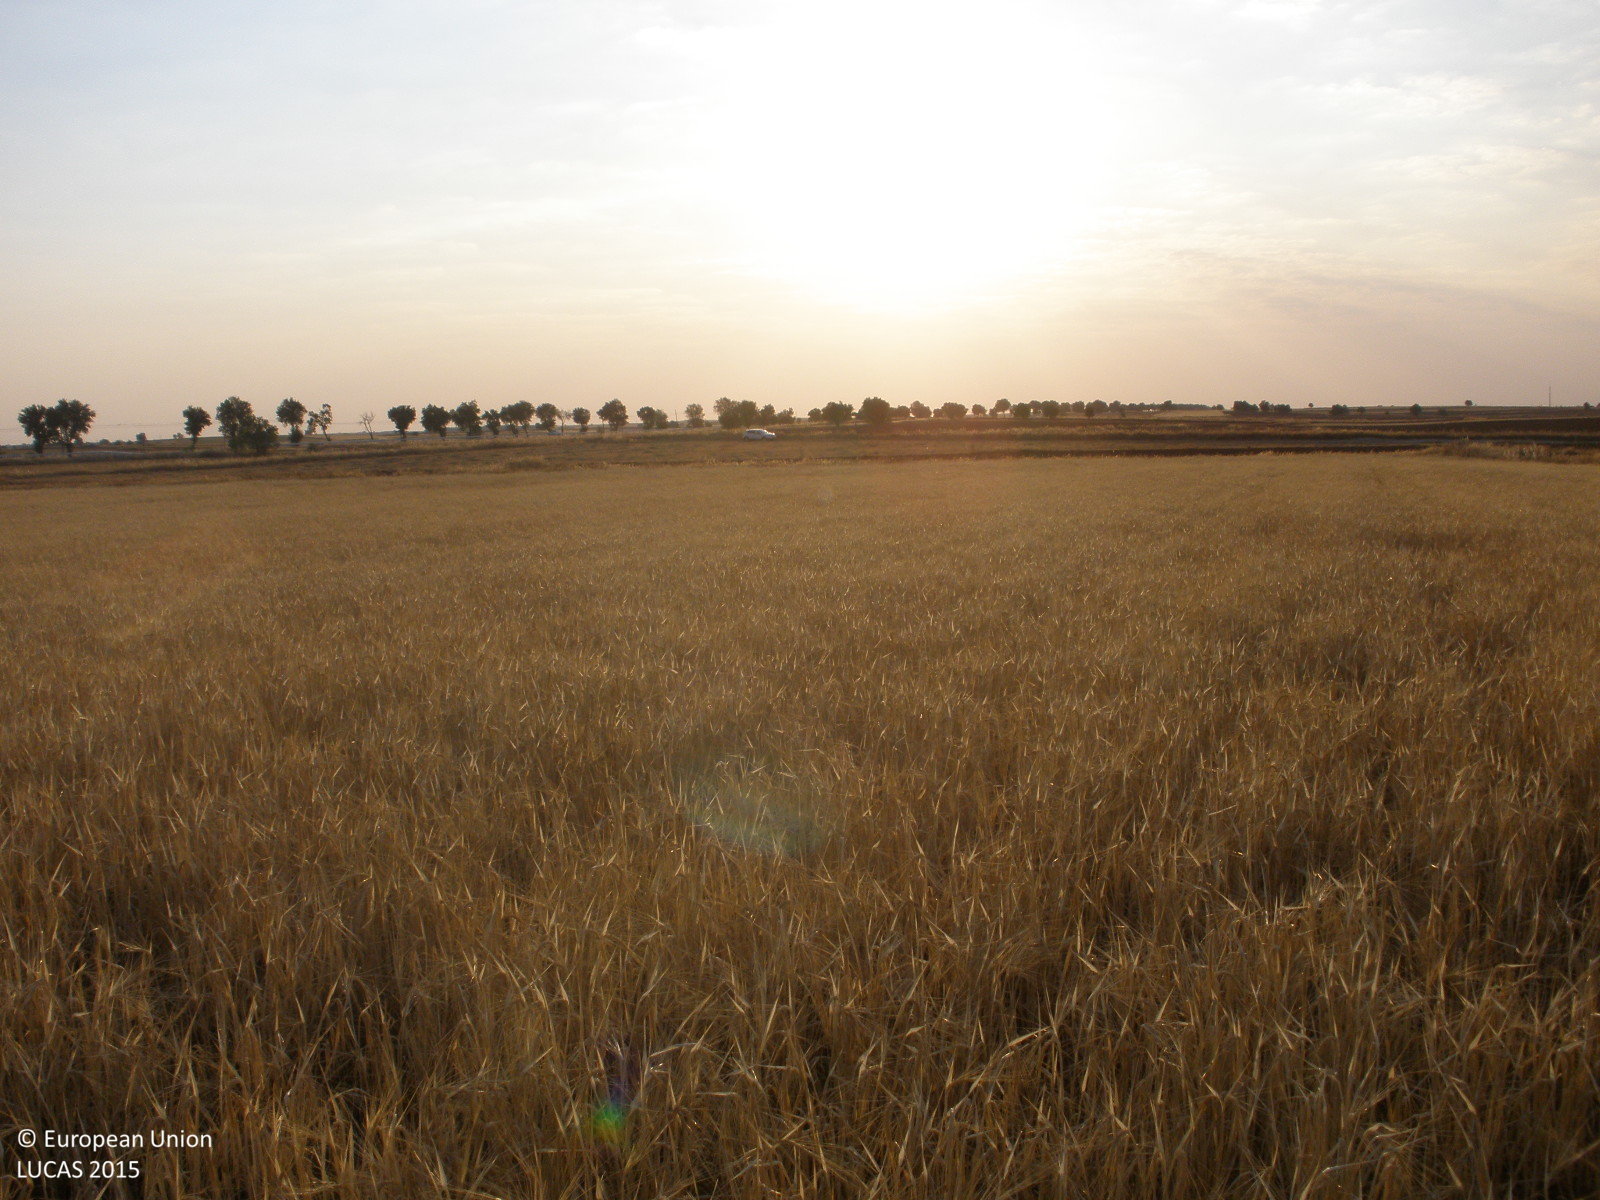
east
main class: Cropland
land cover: Barley
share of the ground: > 75 %
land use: Agriculture (excluding fallow land and kitchen gardens)
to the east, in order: Barley; Grass margins; Other bare soil; Grass margins; Tracks; Grass margins; Other bare soil; Grass margins; Tracks; Grass margins; Other bare soil
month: June
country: ES
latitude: 40.3397
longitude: -3.3459
